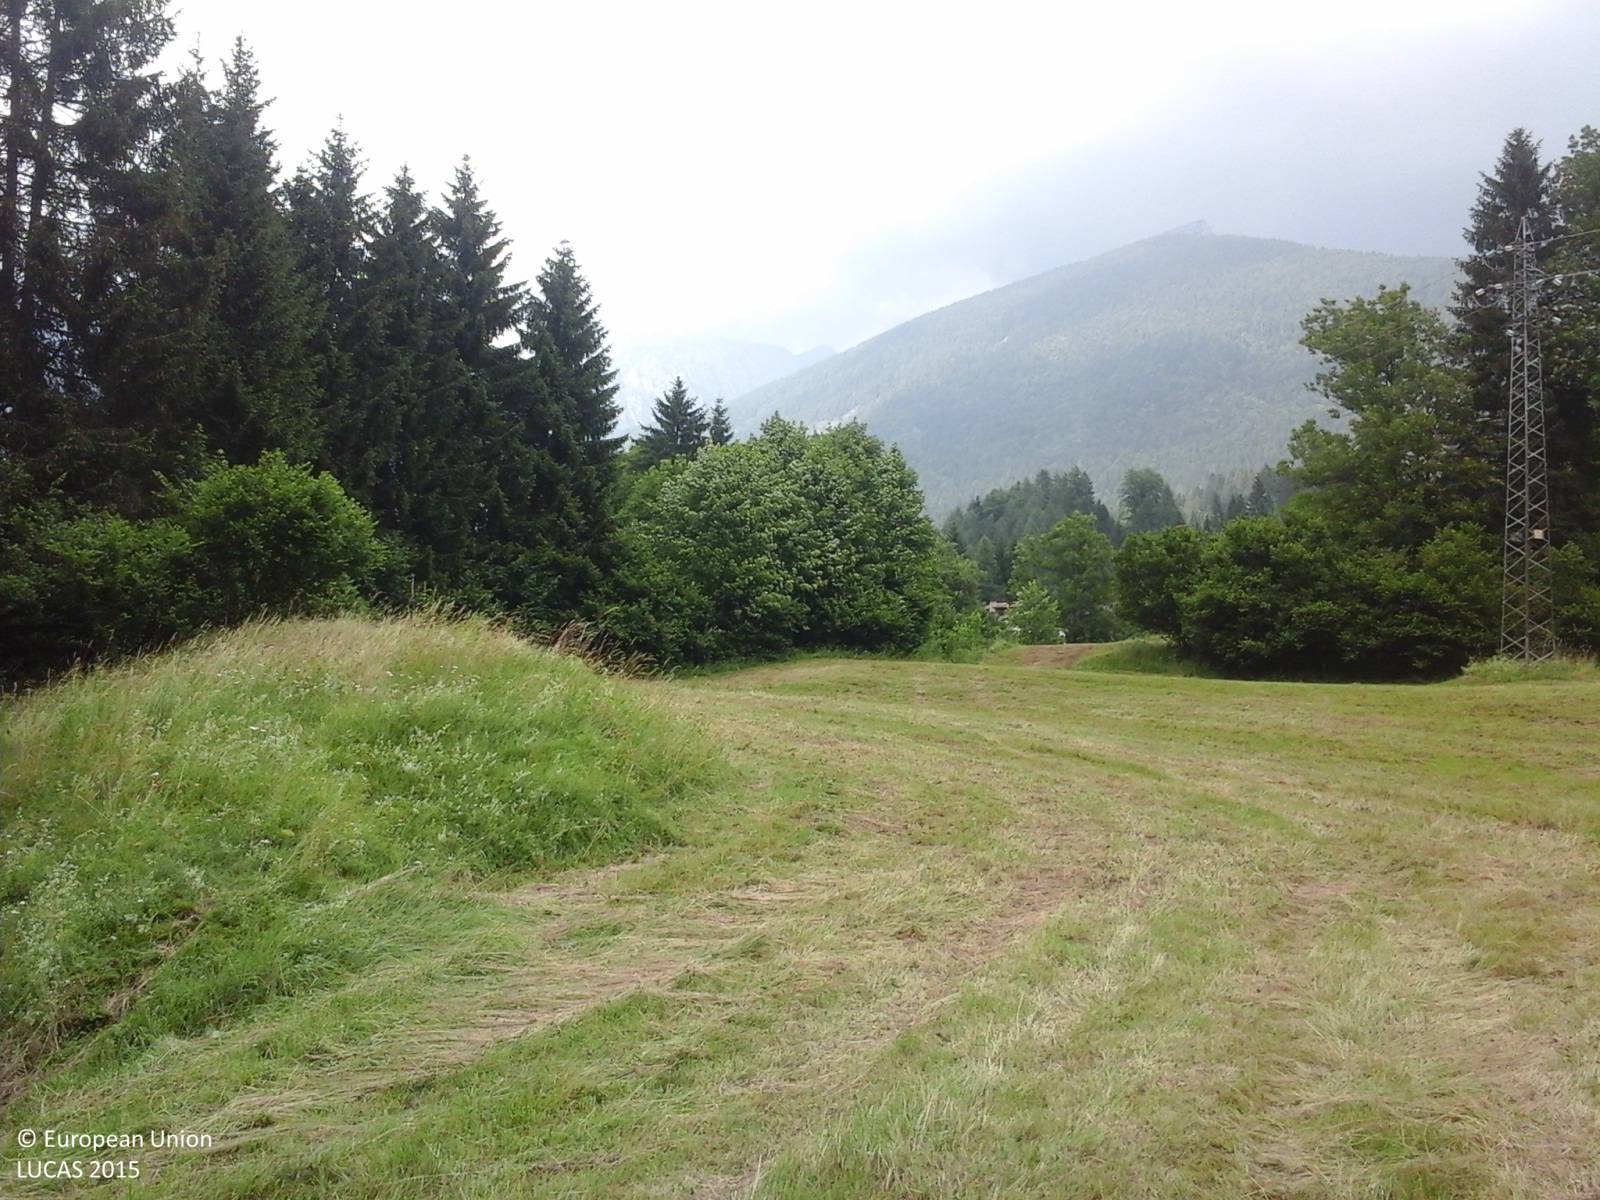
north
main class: Grassland
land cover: Grassland without tree/shrub cover
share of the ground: > 75 %
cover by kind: herbaceous plants 100 %
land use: Agriculture (excluding fallow land and kitchen gardens)
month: July
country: IT
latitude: 46.4101
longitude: 12.5859
